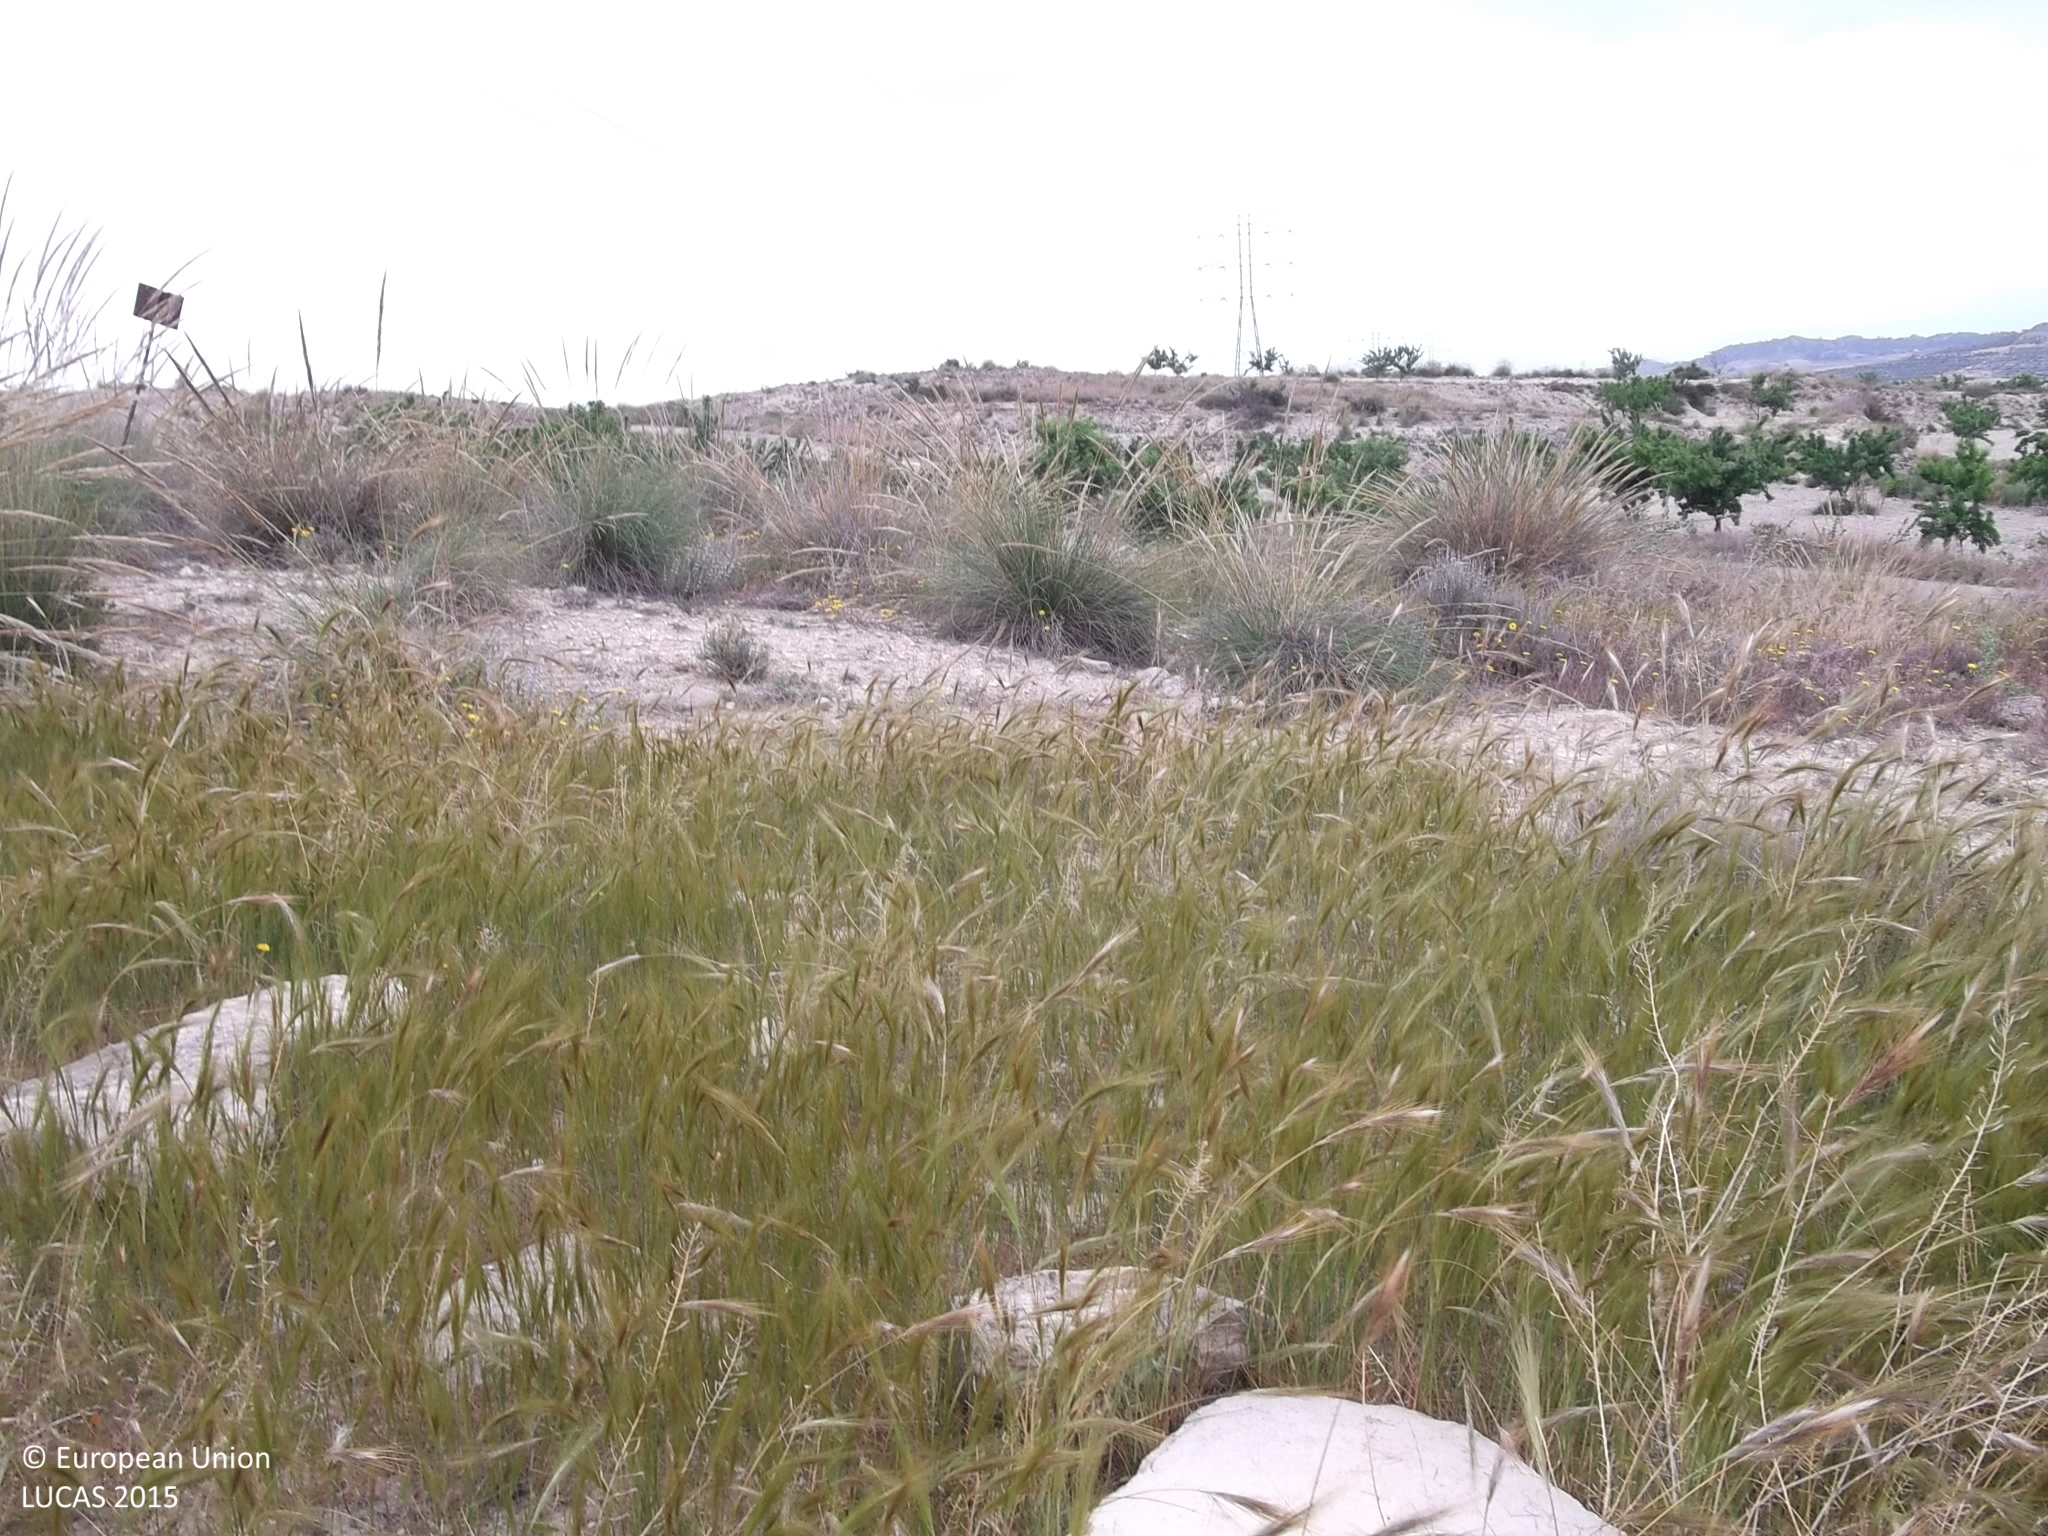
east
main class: Cropland
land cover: Nuts trees
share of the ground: 10 - 25 %
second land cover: Other bare soil
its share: > 75 %
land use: Agriculture (excluding fallow land and kitchen gardens)
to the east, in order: Nuts trees; Other bare soil; Shrubland without tree cover; Nuts trees; Grass margins; Nuts trees; Shrubland without tree cover; Paved roads, cycling and walking lanes; Shrubland without tree cover; Tracks; Grass margins; Spontaneously vegetated surfaces; Electric lines; Spontaneously vegetated surfaces
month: April
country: ES
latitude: 37.9919
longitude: -1.4061
